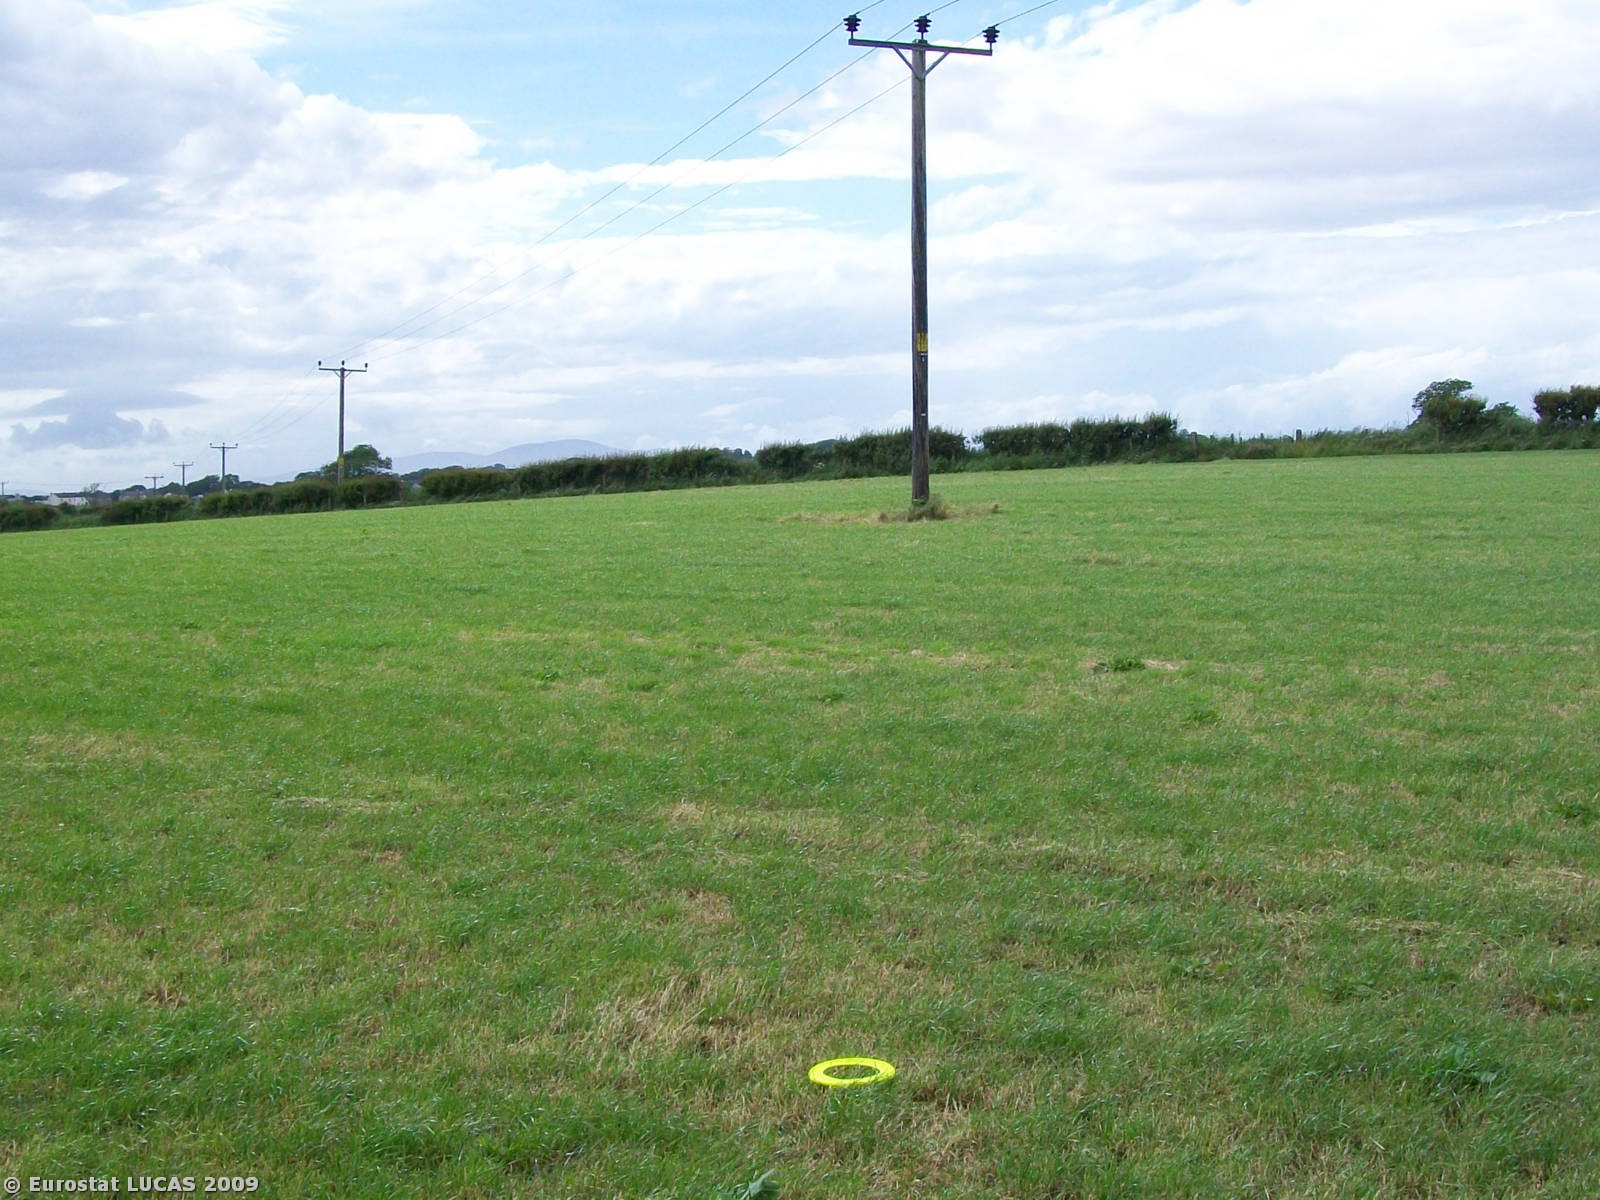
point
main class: Cropland
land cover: Temporary grasslands
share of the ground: > 75 %
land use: Agriculture (excluding fallow land and kitchen gardens)
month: June
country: GB
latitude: 54.8382
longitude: -3.2646
